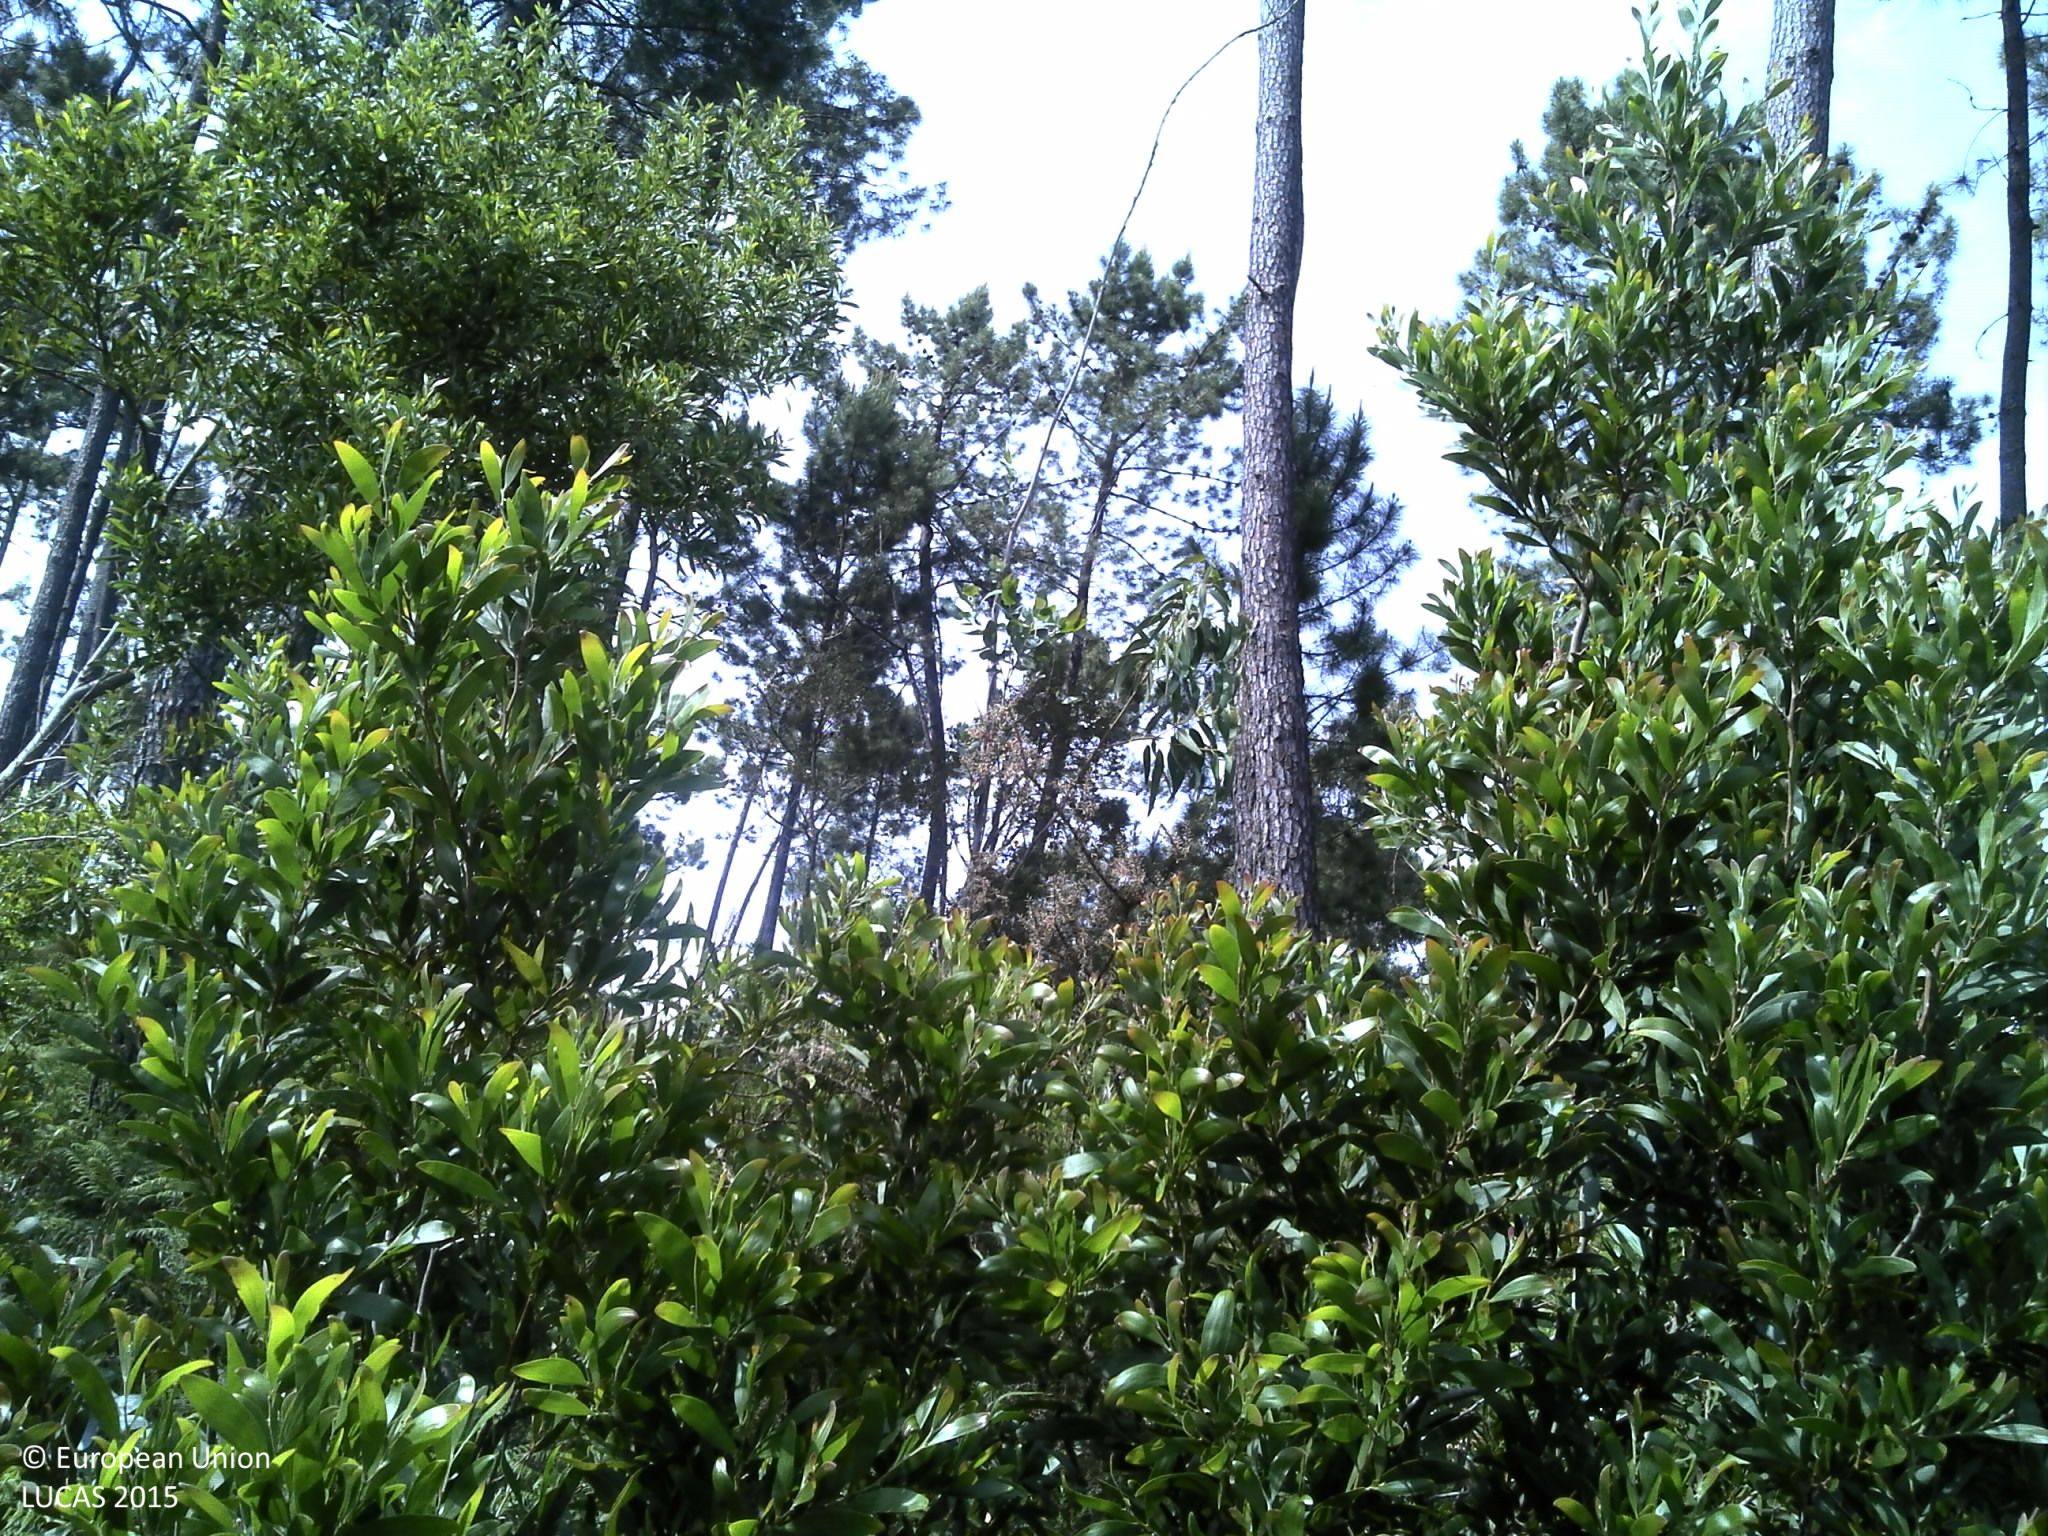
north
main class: Woodland
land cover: Pine dominated coniferous woodland
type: coniferous forest of the mediterranean region
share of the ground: 50 - 75 %
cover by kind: coniferous forest trees 75 %, shrubs 20 %, unconsolidated bare surface 5 %
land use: Forestry
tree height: > 5 m
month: May
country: PT
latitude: 40.9375
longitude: -8.3736
